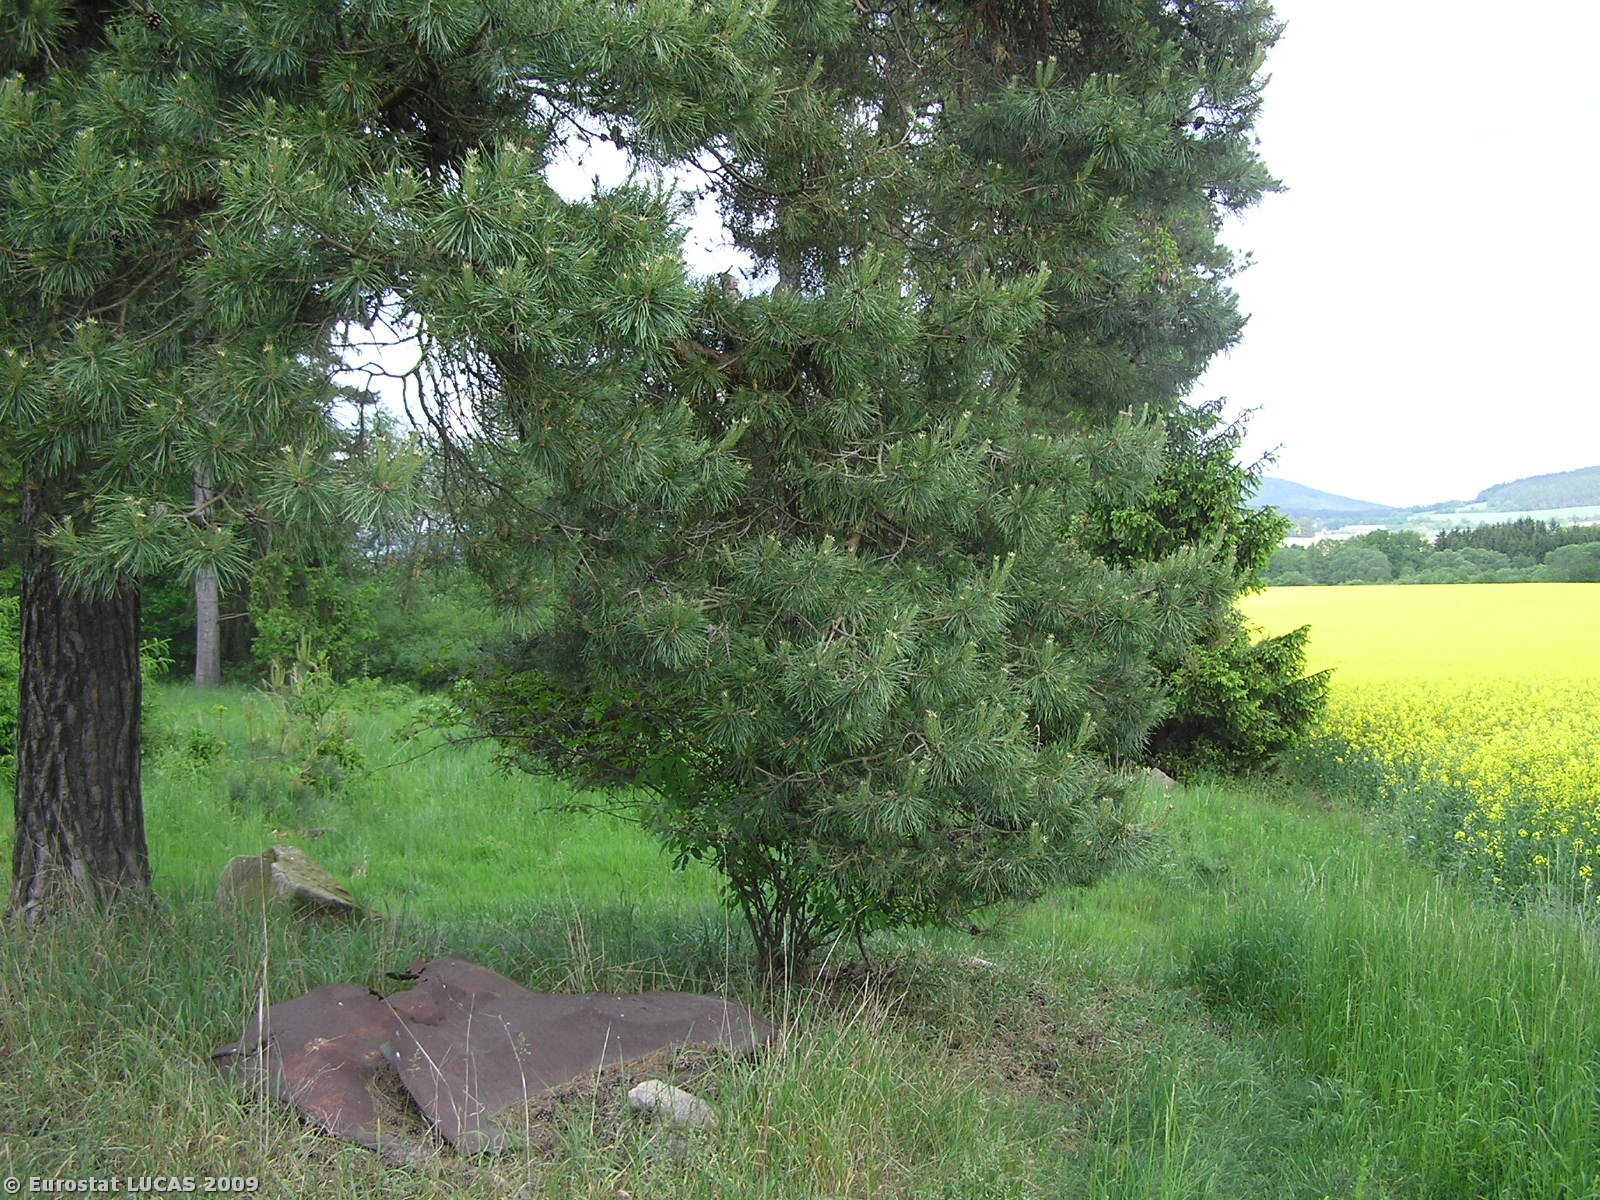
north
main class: Cropland
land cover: Rape and turnip rape
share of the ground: > 75 %
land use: Agriculture (excluding fallow land and kitchen gardens)
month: May
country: CZ
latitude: 49.5943
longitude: 14.8582
